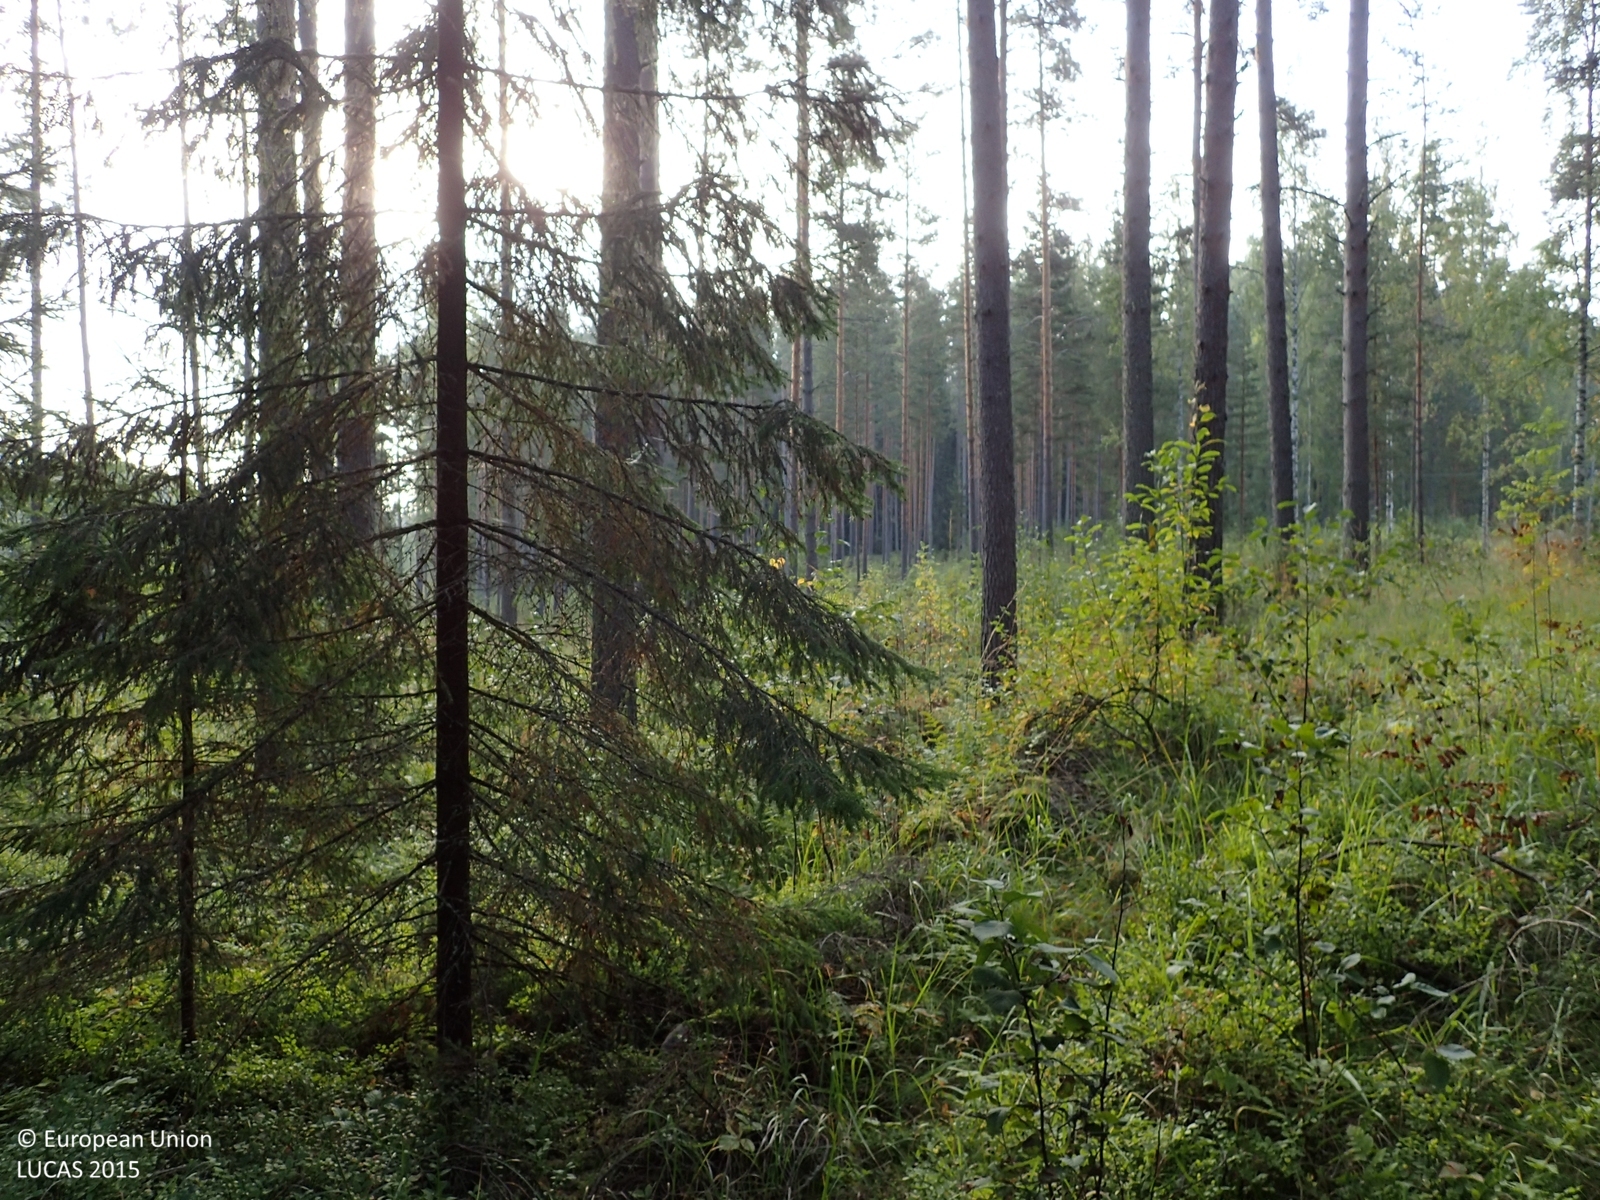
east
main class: Woodland
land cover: Other coniferous woodland
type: boreal forest
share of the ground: > 75 %
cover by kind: coniferous forest trees 70 %, shrubs 20 %, broadleaved forest trees 5 %, herbaceous plants 5 %
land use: Forestry
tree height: > 5 m
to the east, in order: Other coniferous woodland; Pine dominated coniferous woodland; Tracks; Electric lines; Grassland without tree/shrub cover; Broadleaved woodland; Spontaneously vegetated surfaces
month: September
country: FI
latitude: 63.0665
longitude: 25.7653
